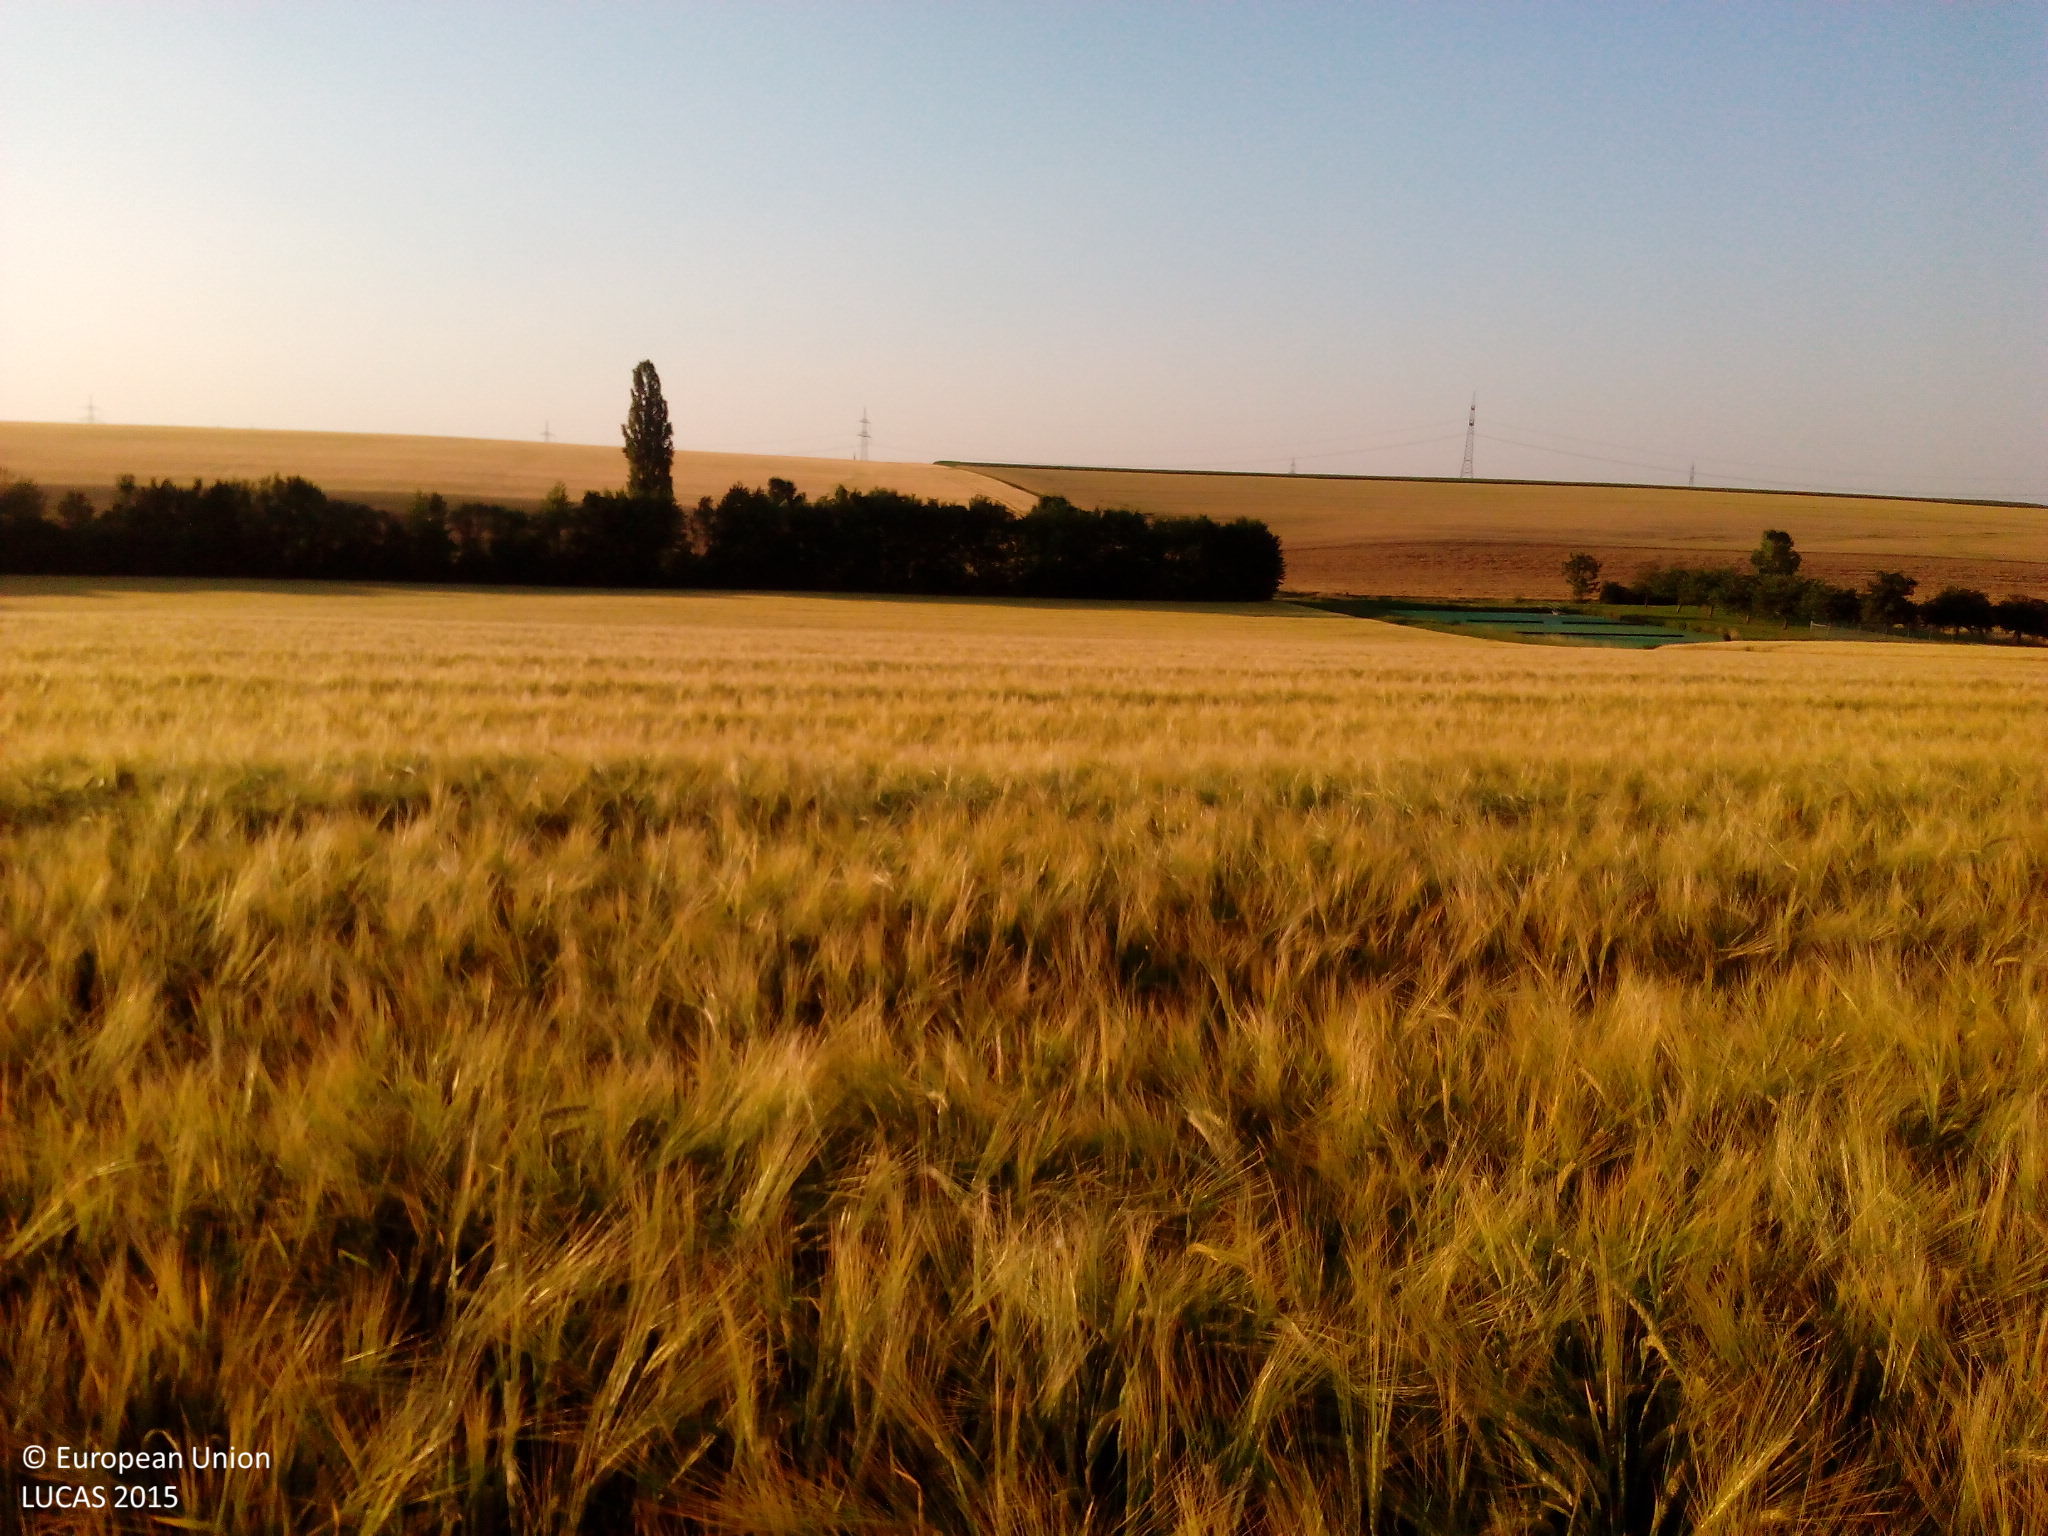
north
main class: Cropland
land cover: Barley
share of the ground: > 75 %
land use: Agriculture (excluding fallow land and kitchen gardens)
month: July
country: DE
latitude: 49.6087
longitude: 9.9032
